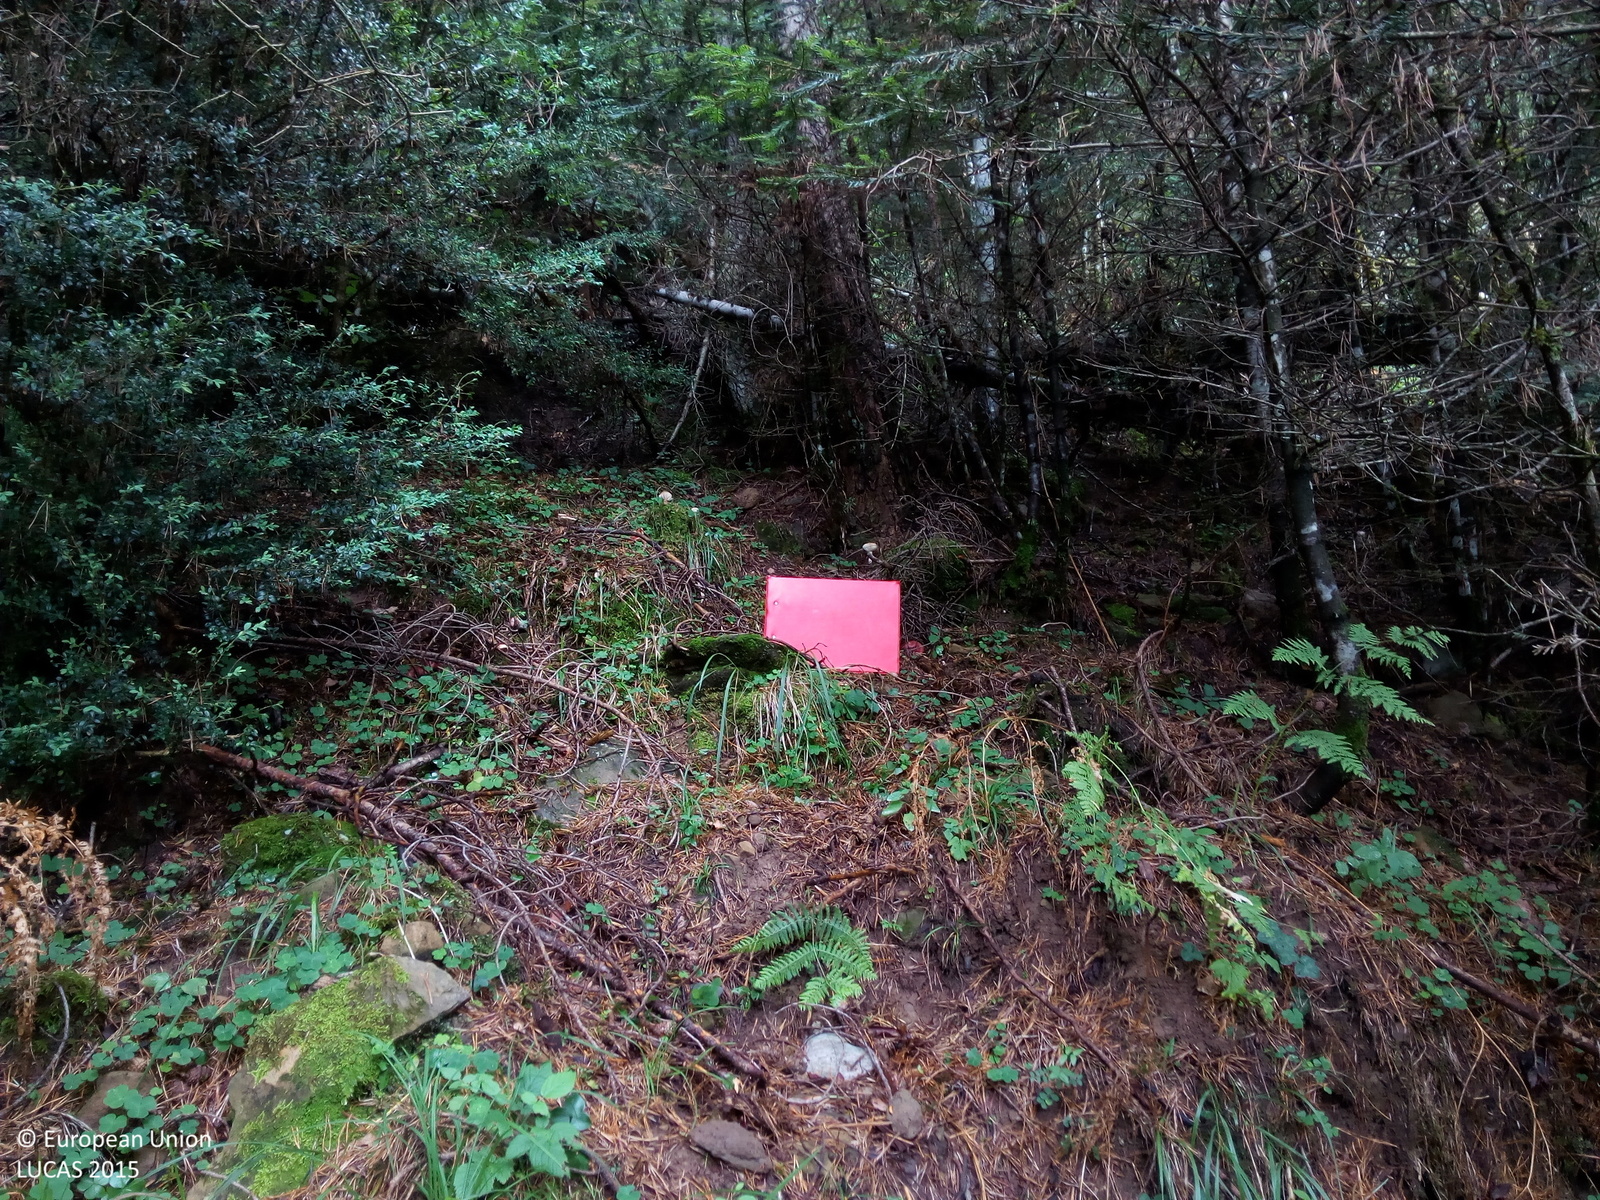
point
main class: Woodland
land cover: Spruce dominated coniferous woodland
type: alpine coniferous forest
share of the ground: > 75 %
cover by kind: coniferous forest trees 90 %, shrubs 10 %
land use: Semi-natural and natural areas not in use
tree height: > 5 m
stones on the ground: < 10 %
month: September
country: ES
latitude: 42.6308
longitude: 0.1857
